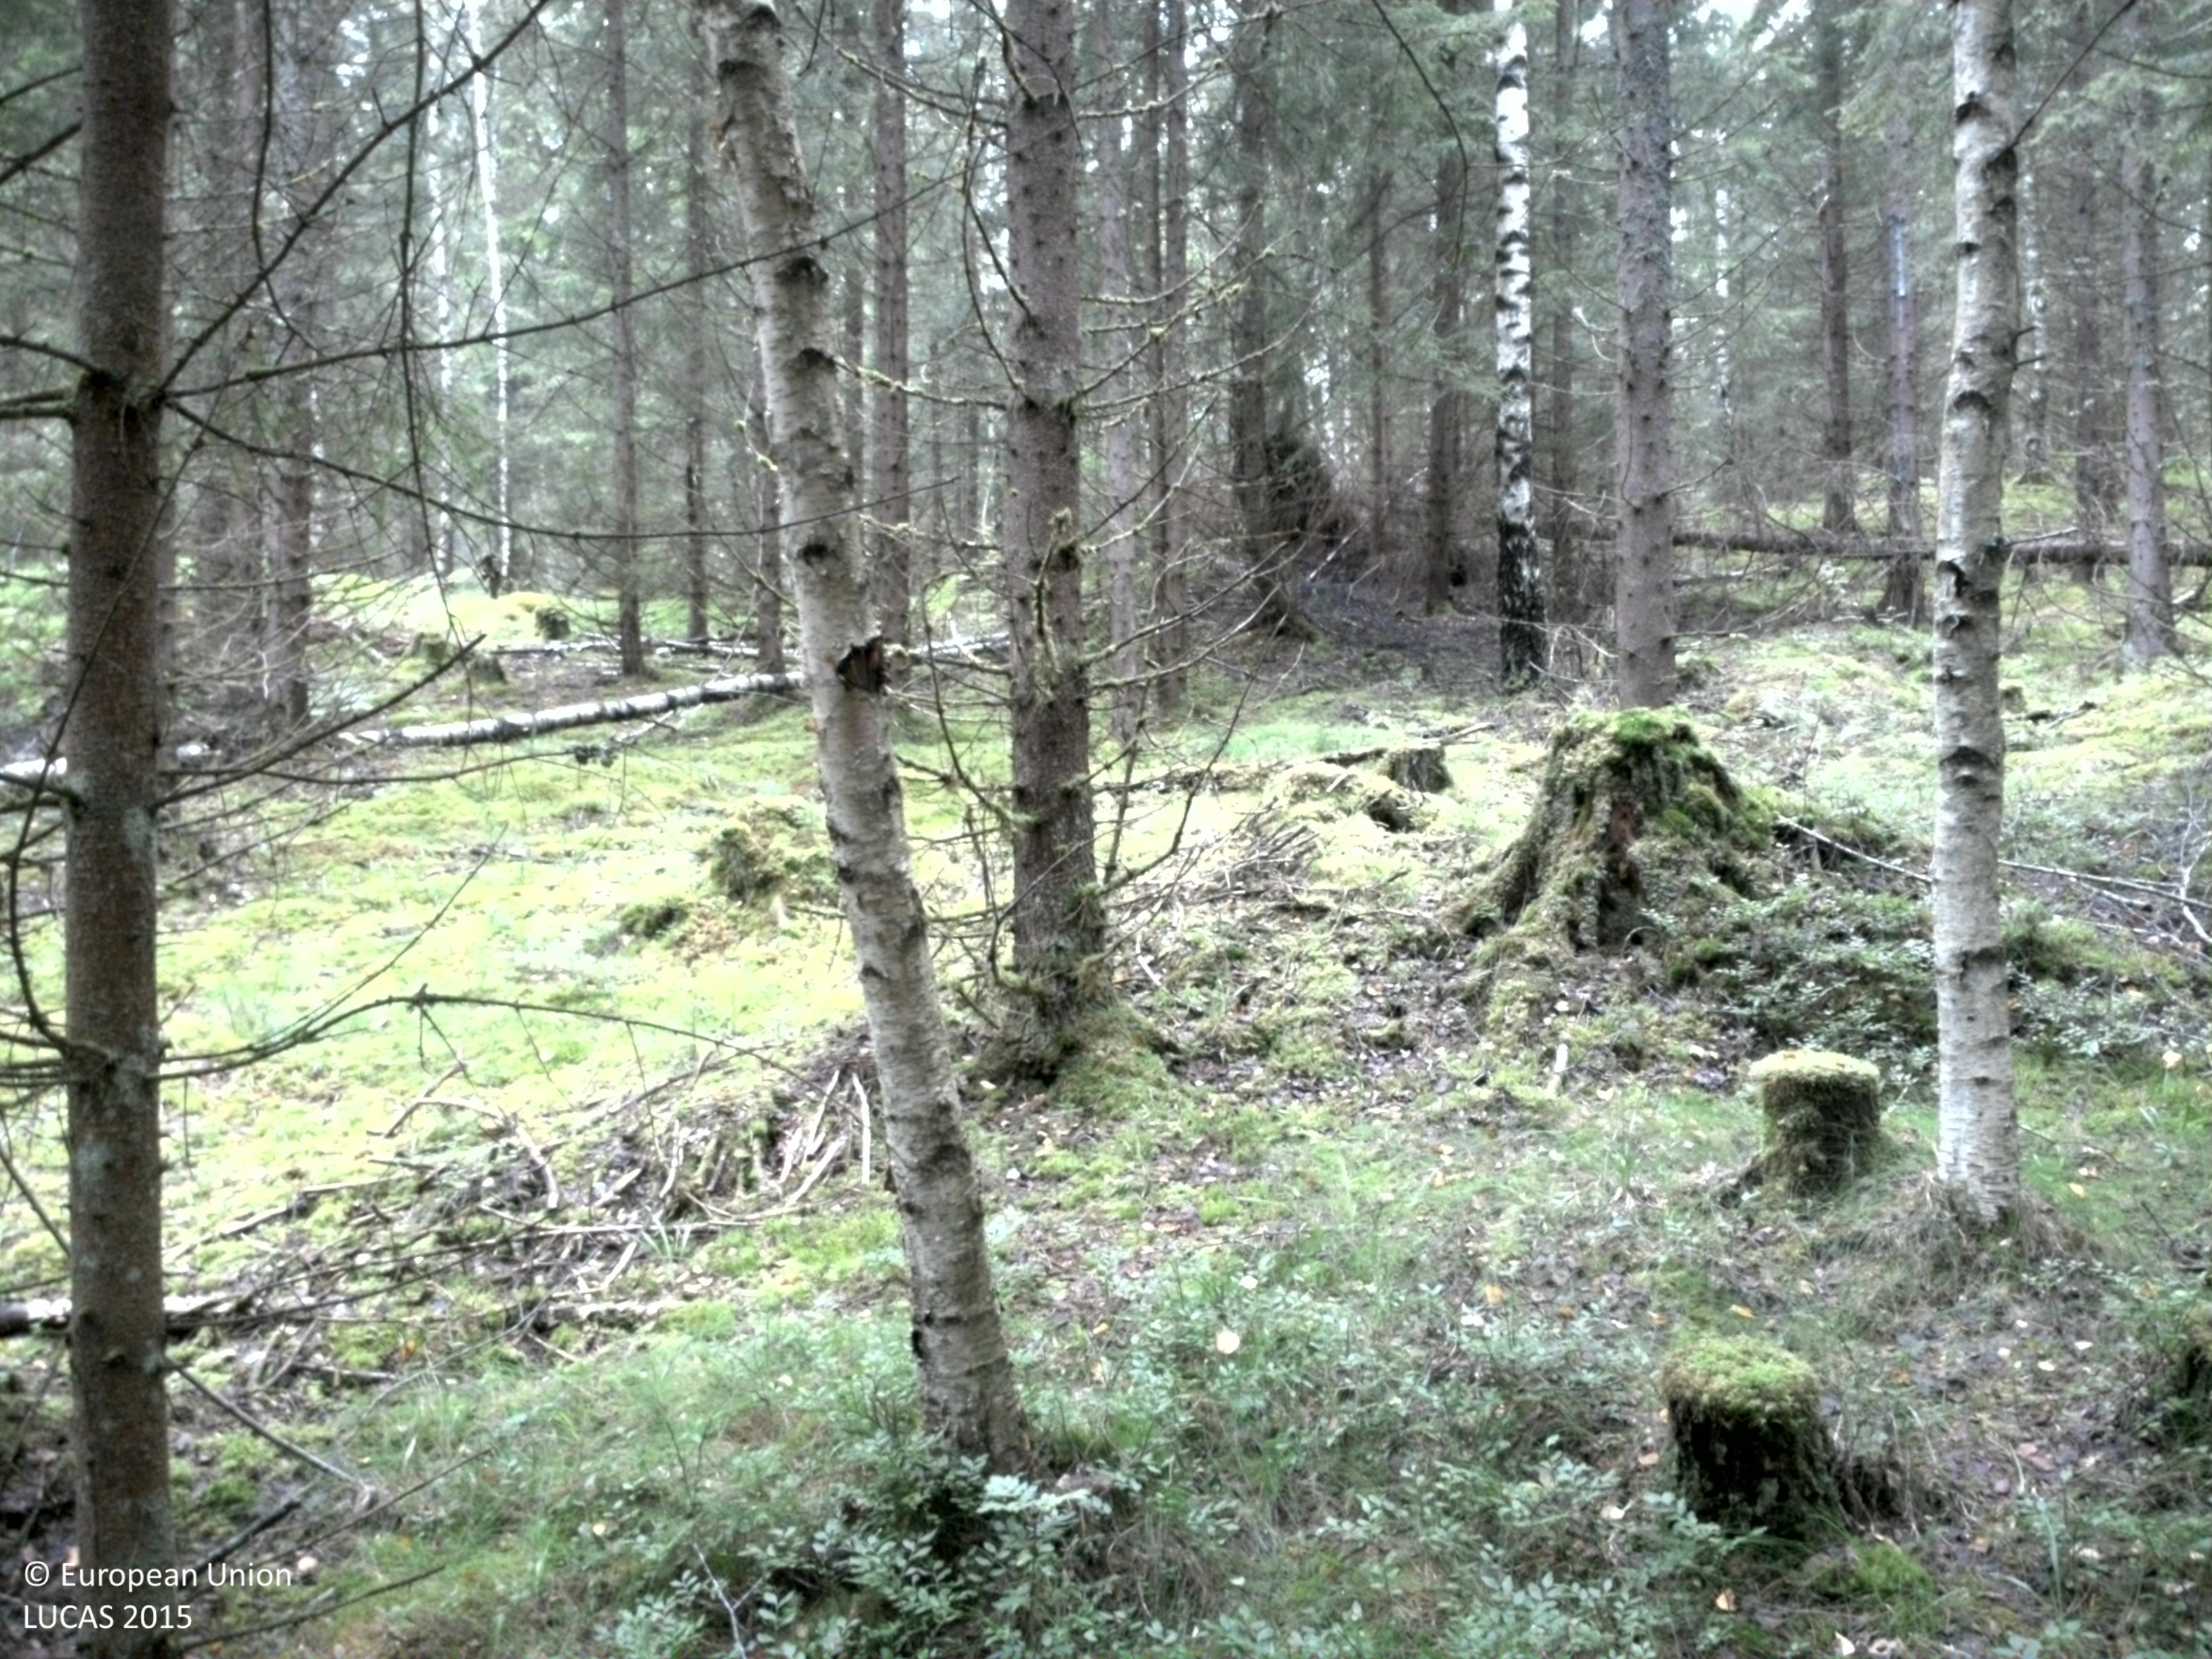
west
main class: Woodland
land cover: Spruce dominated coniferous woodland
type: boreal forest
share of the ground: 50 - 75 %
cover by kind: coniferous forest trees 65 %, lichens and mosses 20 %, broadleaved forest trees 5 %, shrubs 5 %, herbaceous plants 5 %
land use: Forestry
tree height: > 5 m
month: August
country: SE
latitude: 59.6219
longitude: 13.2009
